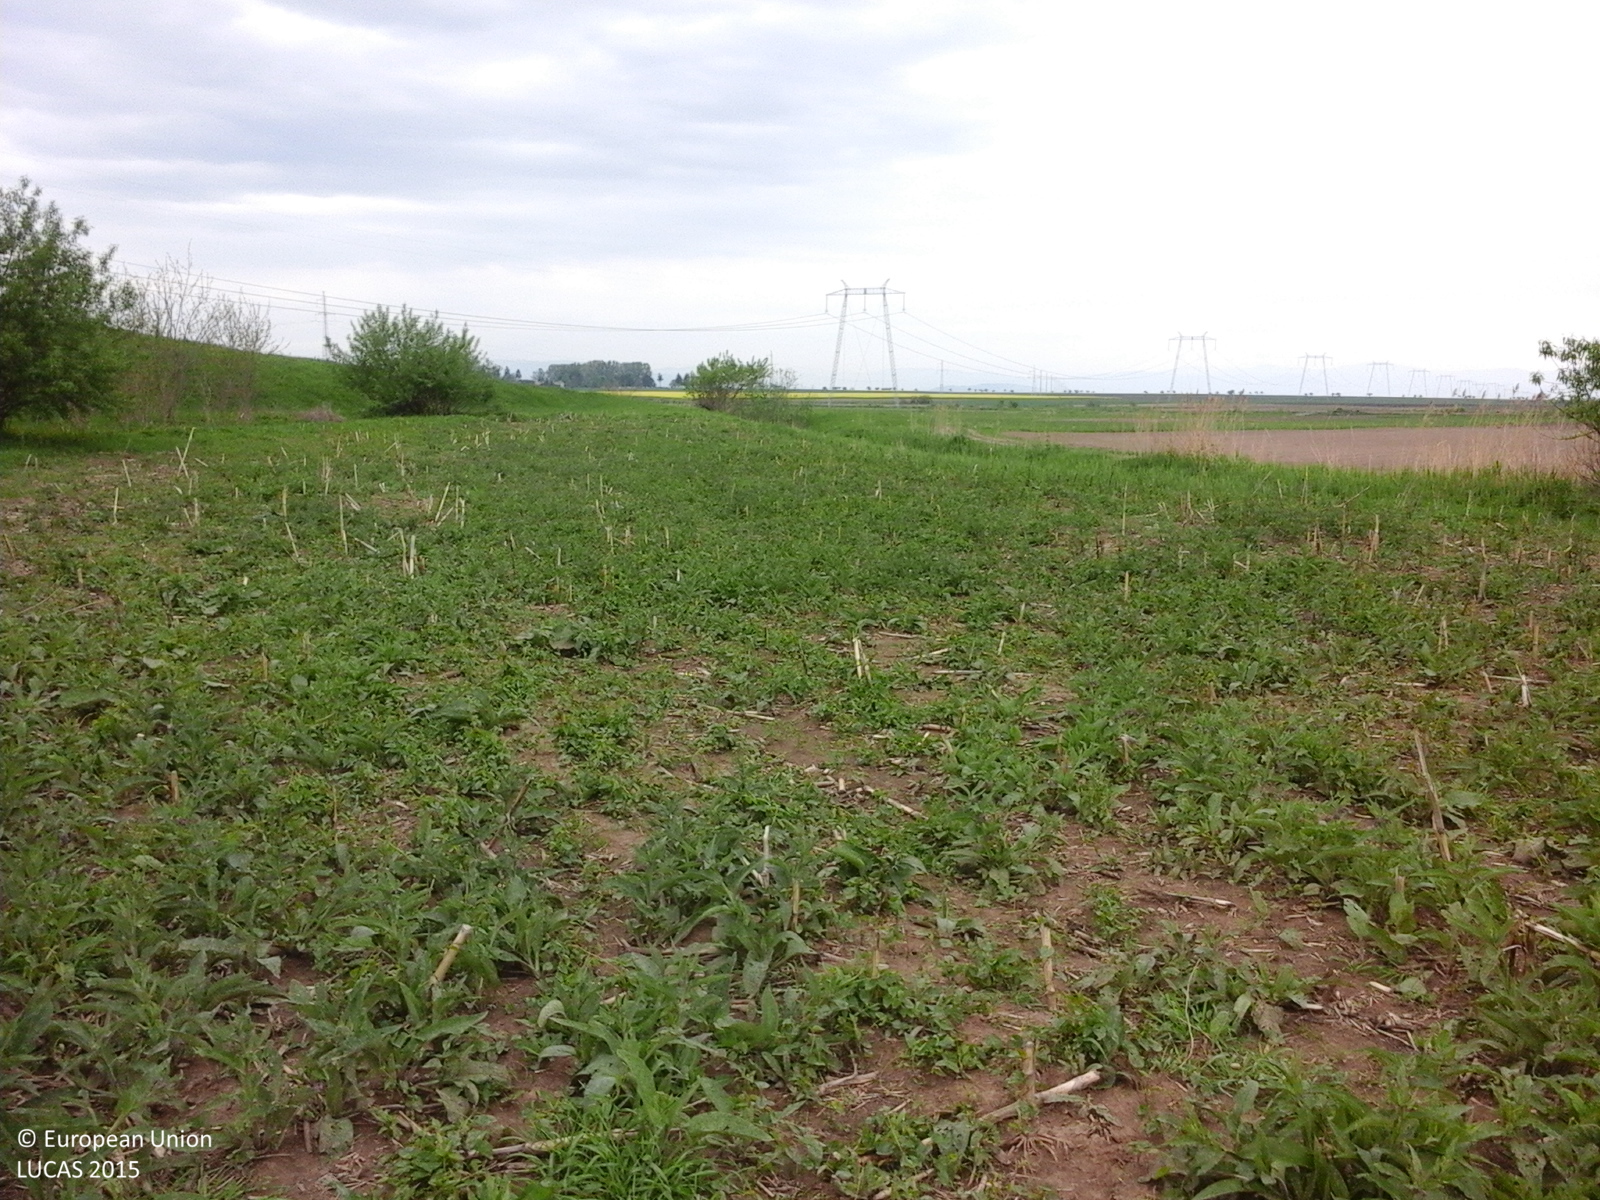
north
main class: Grassland
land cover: Spontaneously vegetated surfaces
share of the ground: 50 - 75 %
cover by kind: herbaceous plants 100 %
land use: Fallow land
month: May
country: RO
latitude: 45.8981
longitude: 26.0612
